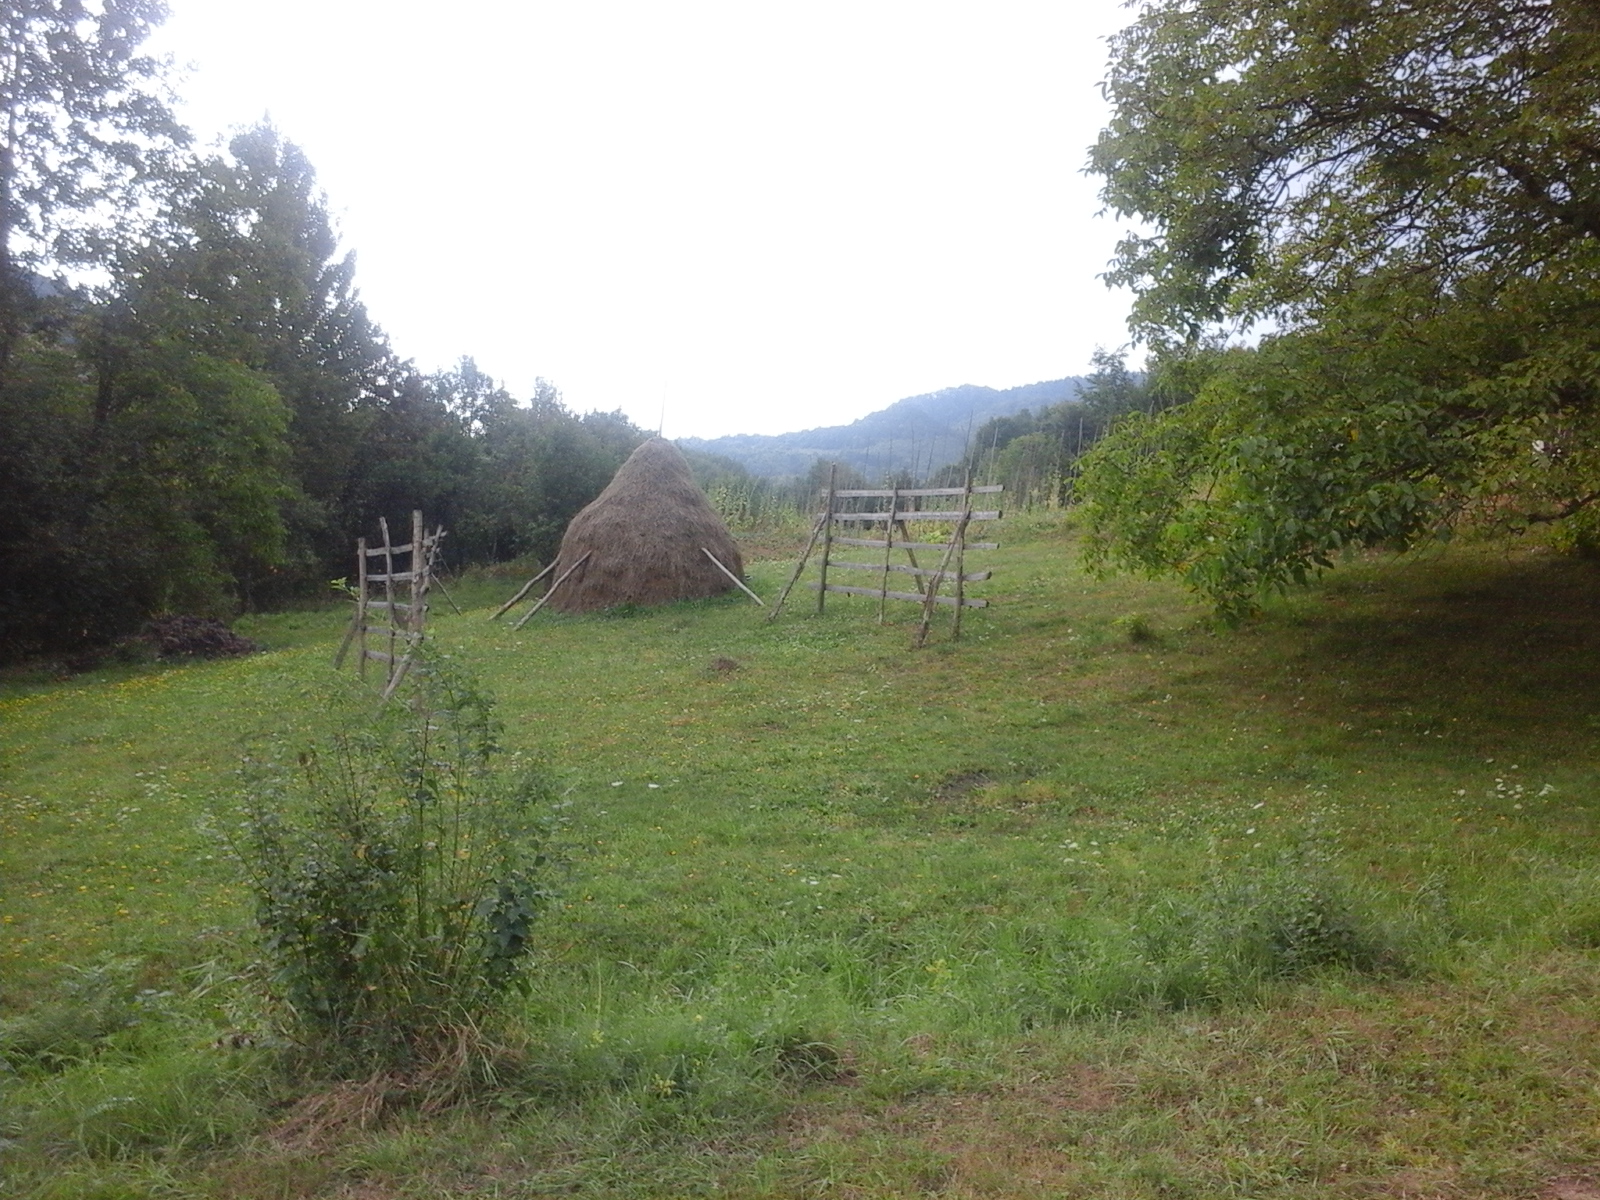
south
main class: Grassland
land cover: Grassland without tree/shrub cover
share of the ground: > 75 %
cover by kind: herbaceous plants 100 %
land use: Agriculture (excluding fallow land and kitchen gardens)
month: September
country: RO
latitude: 47.7174
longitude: 24.0693
